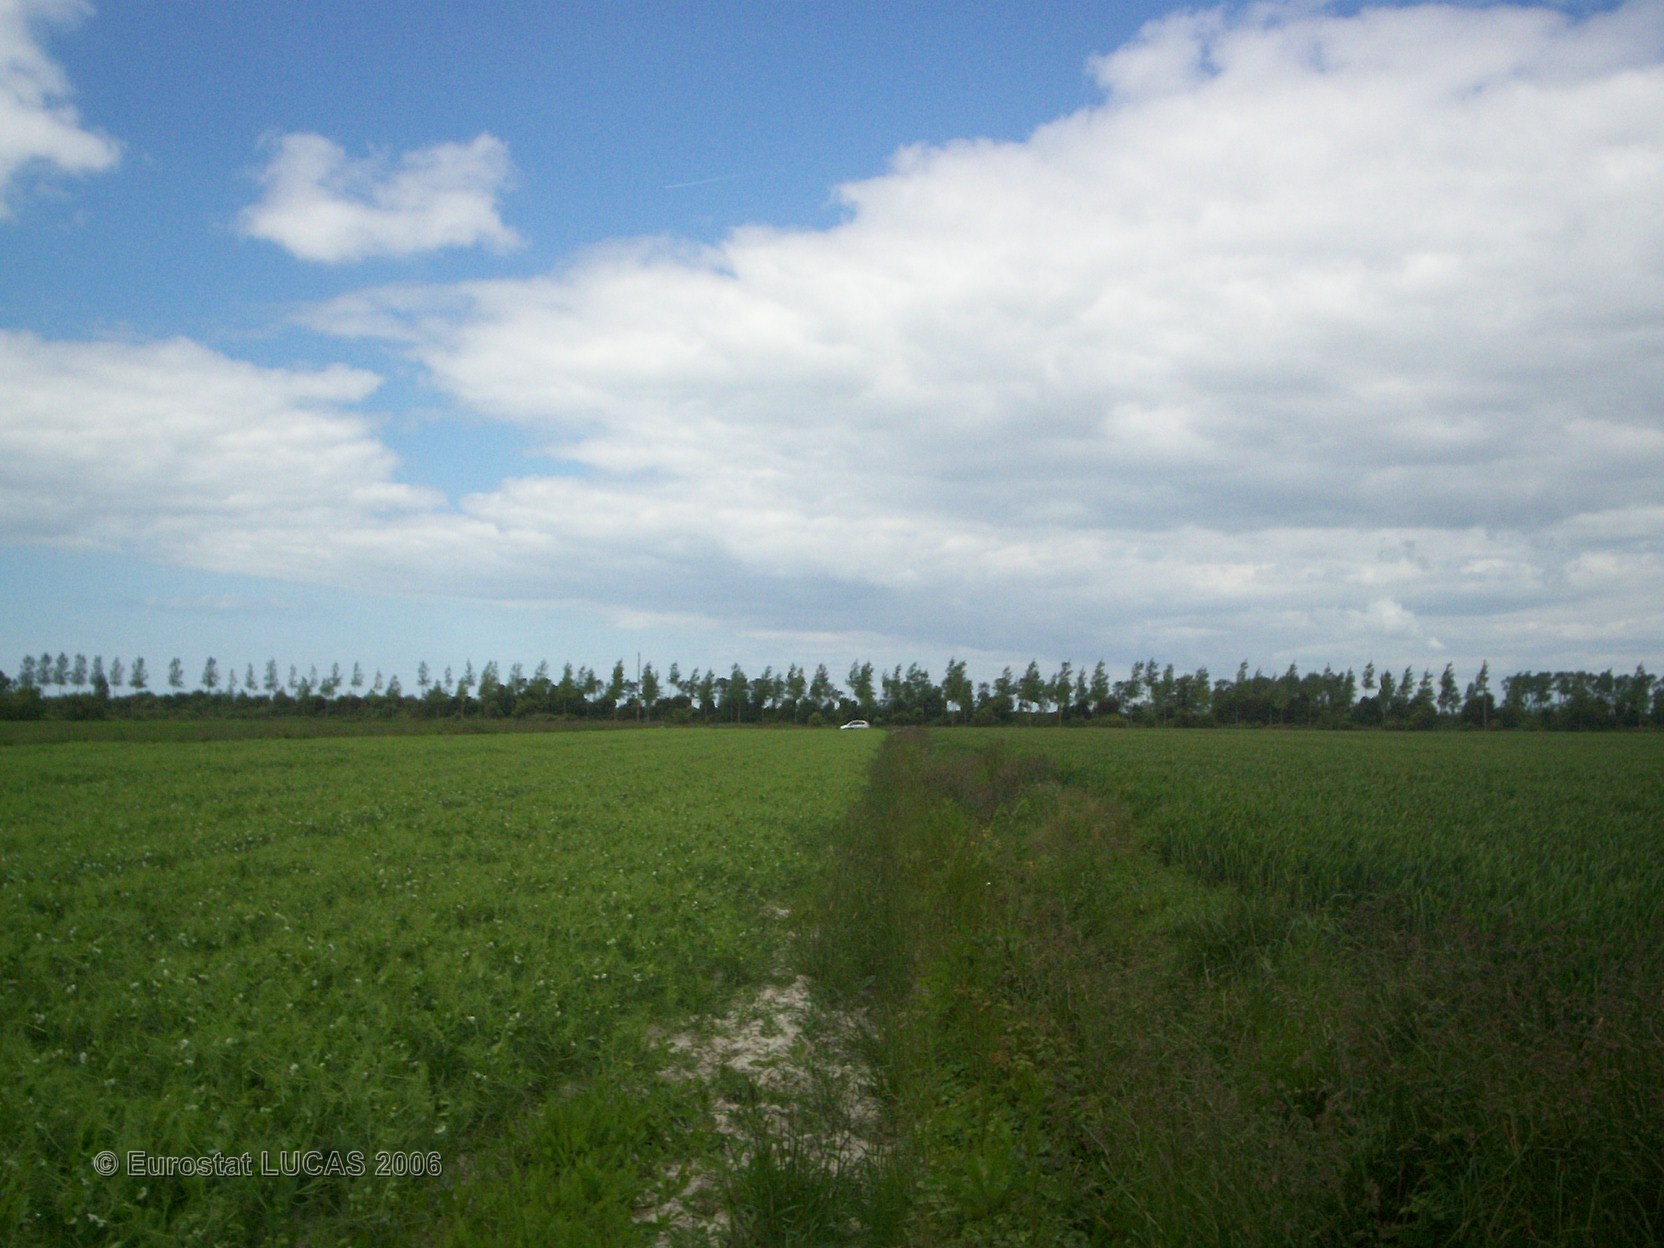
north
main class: Cropland
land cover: Barley
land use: Agriculture (excluding fallow land and kitchen gardens)
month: May
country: FR
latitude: 48.6039
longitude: -1.6444
